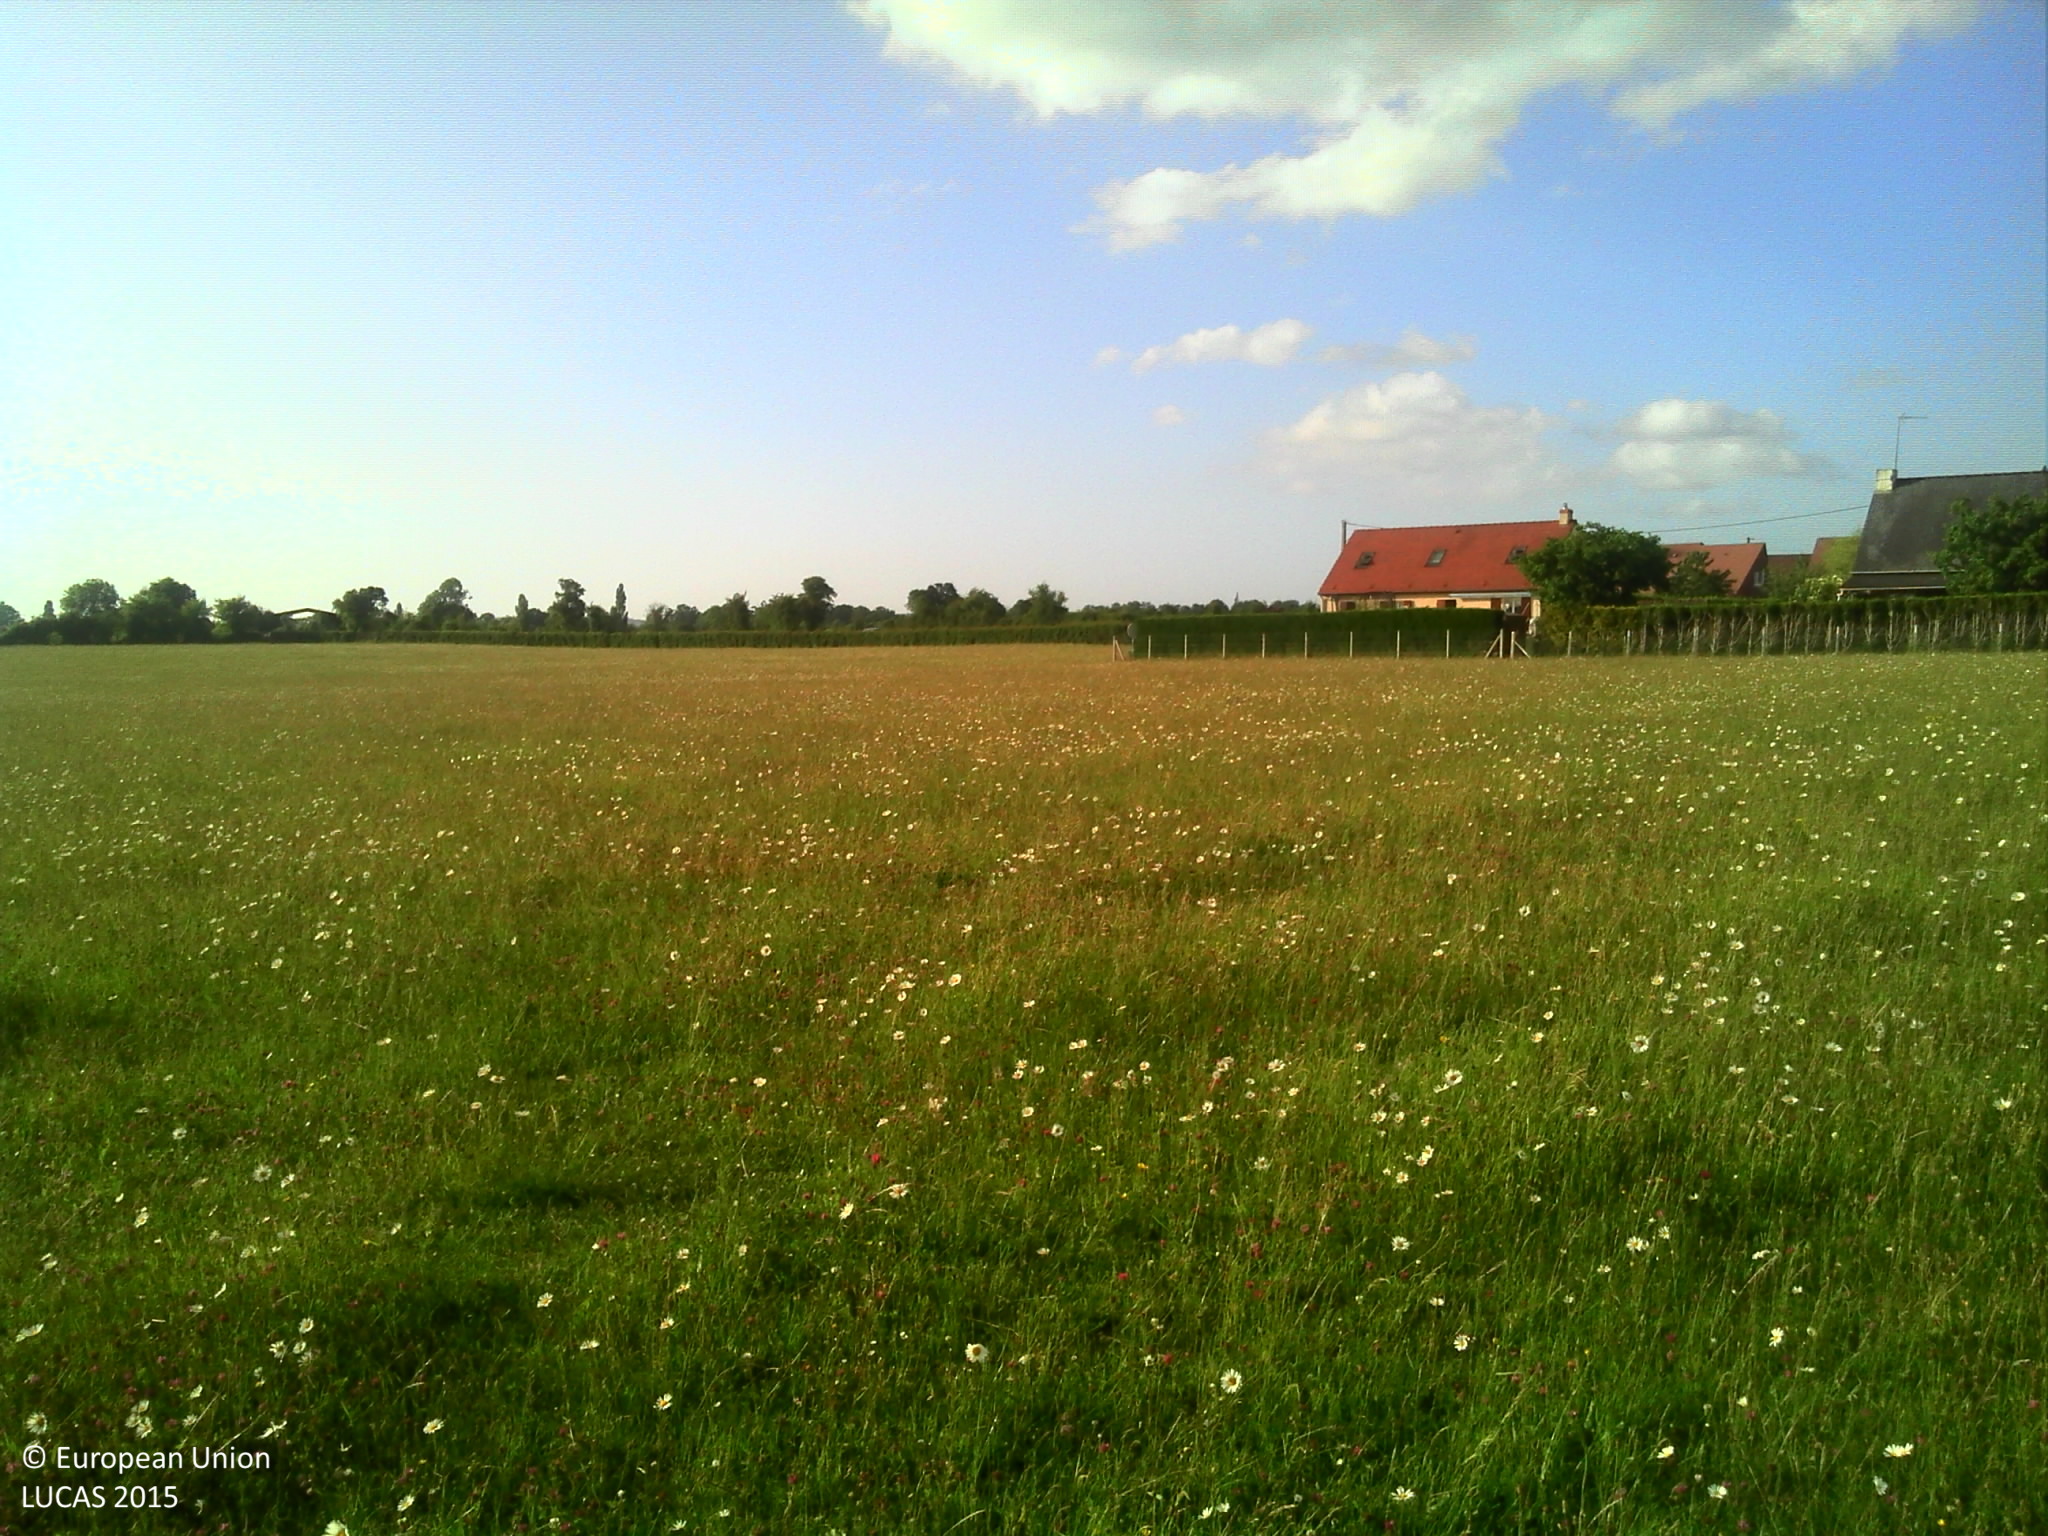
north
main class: Grassland
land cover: Grassland without tree/shrub cover
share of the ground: > 75 %
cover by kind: herbaceous plants 95 %
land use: Agriculture (excluding fallow land and kitchen gardens)
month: June
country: FR
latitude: 48.8099
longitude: 0.0983
